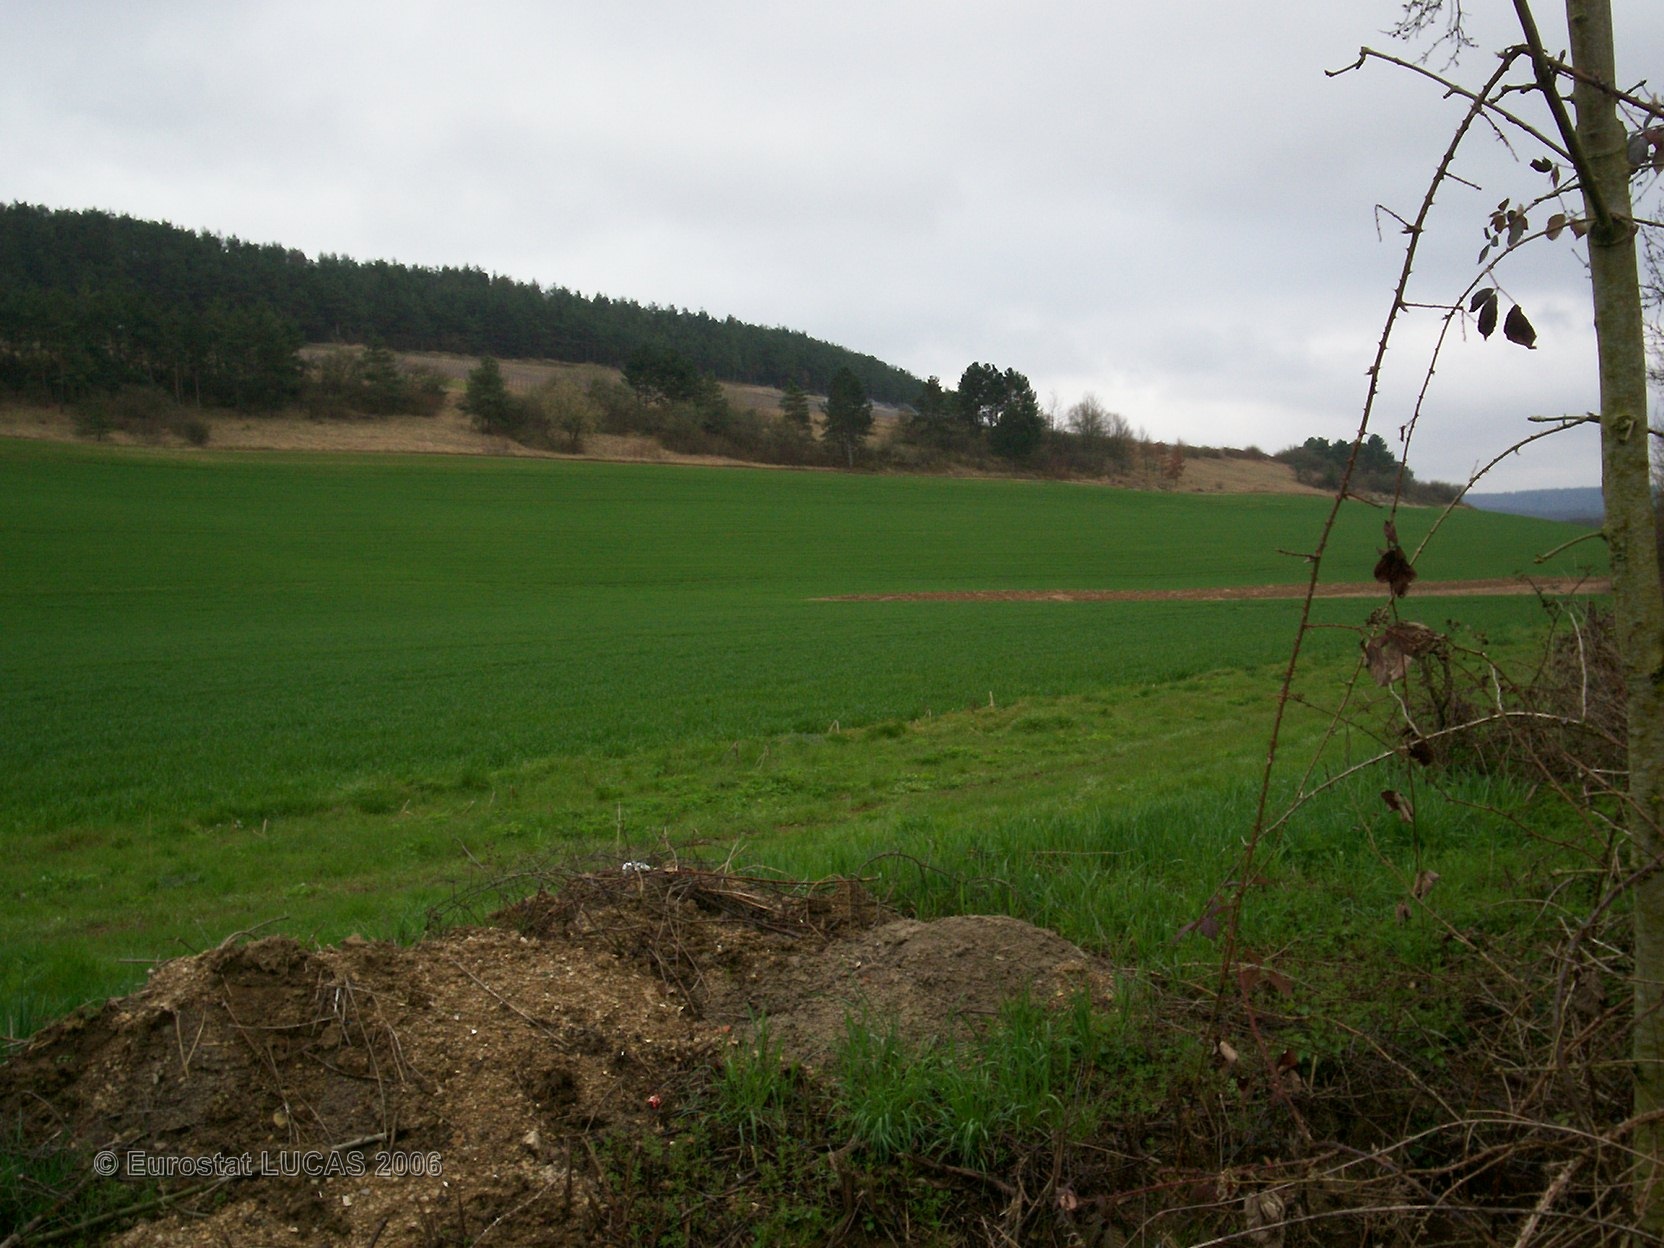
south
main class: Cropland
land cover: Common wheat
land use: Agriculture (excluding fallow land and kitchen gardens)
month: April
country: FR
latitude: 48.0853
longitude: 4.4803
